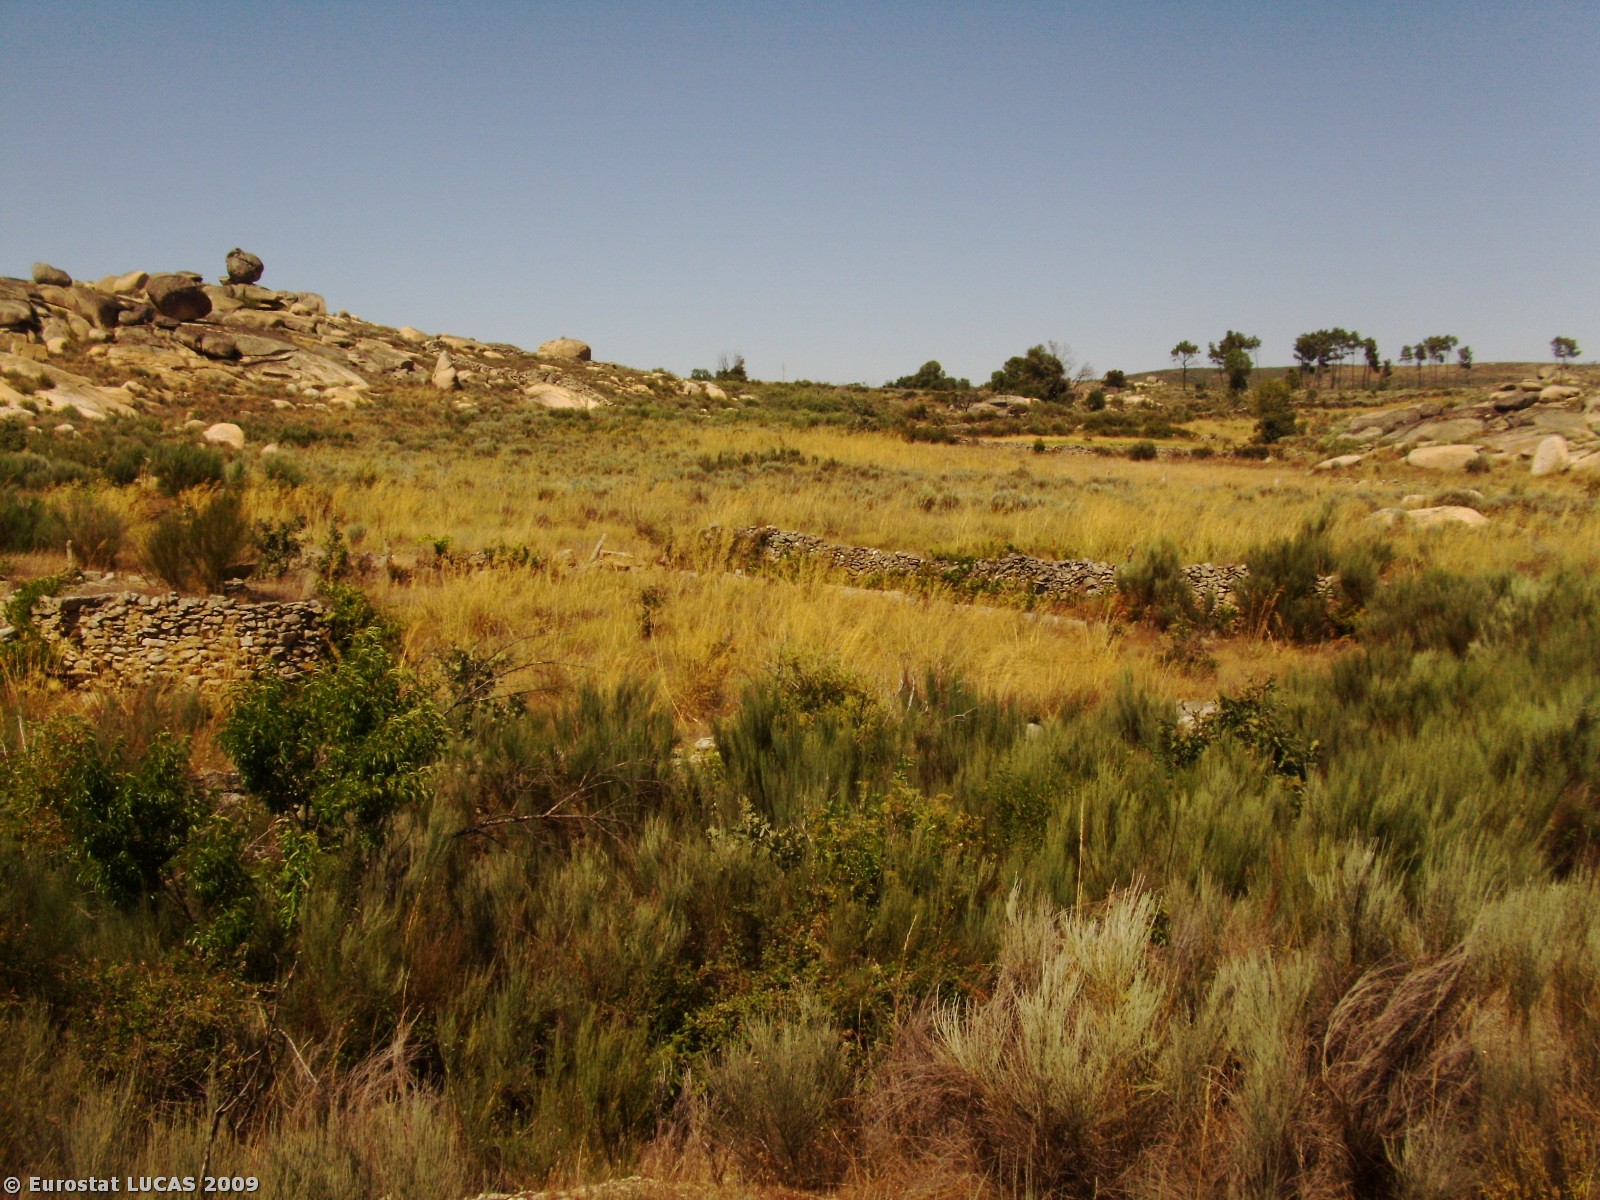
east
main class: Shrubland
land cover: Shrubland with sparse tree cover
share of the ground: > 75 %
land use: Unused
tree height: > 5 m
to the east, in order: Shrubland with sparse tree cover; Dry stone walls; Shrubland with sparse tree cover; Dry stone walls; Shrubland with sparse tree cover; Dry stone walls; Shrubland with sparse tree cover; Dry stone walls; Shrubland with sparse tree cover
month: July
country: PT
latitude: 40.5083
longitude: -7.0829
